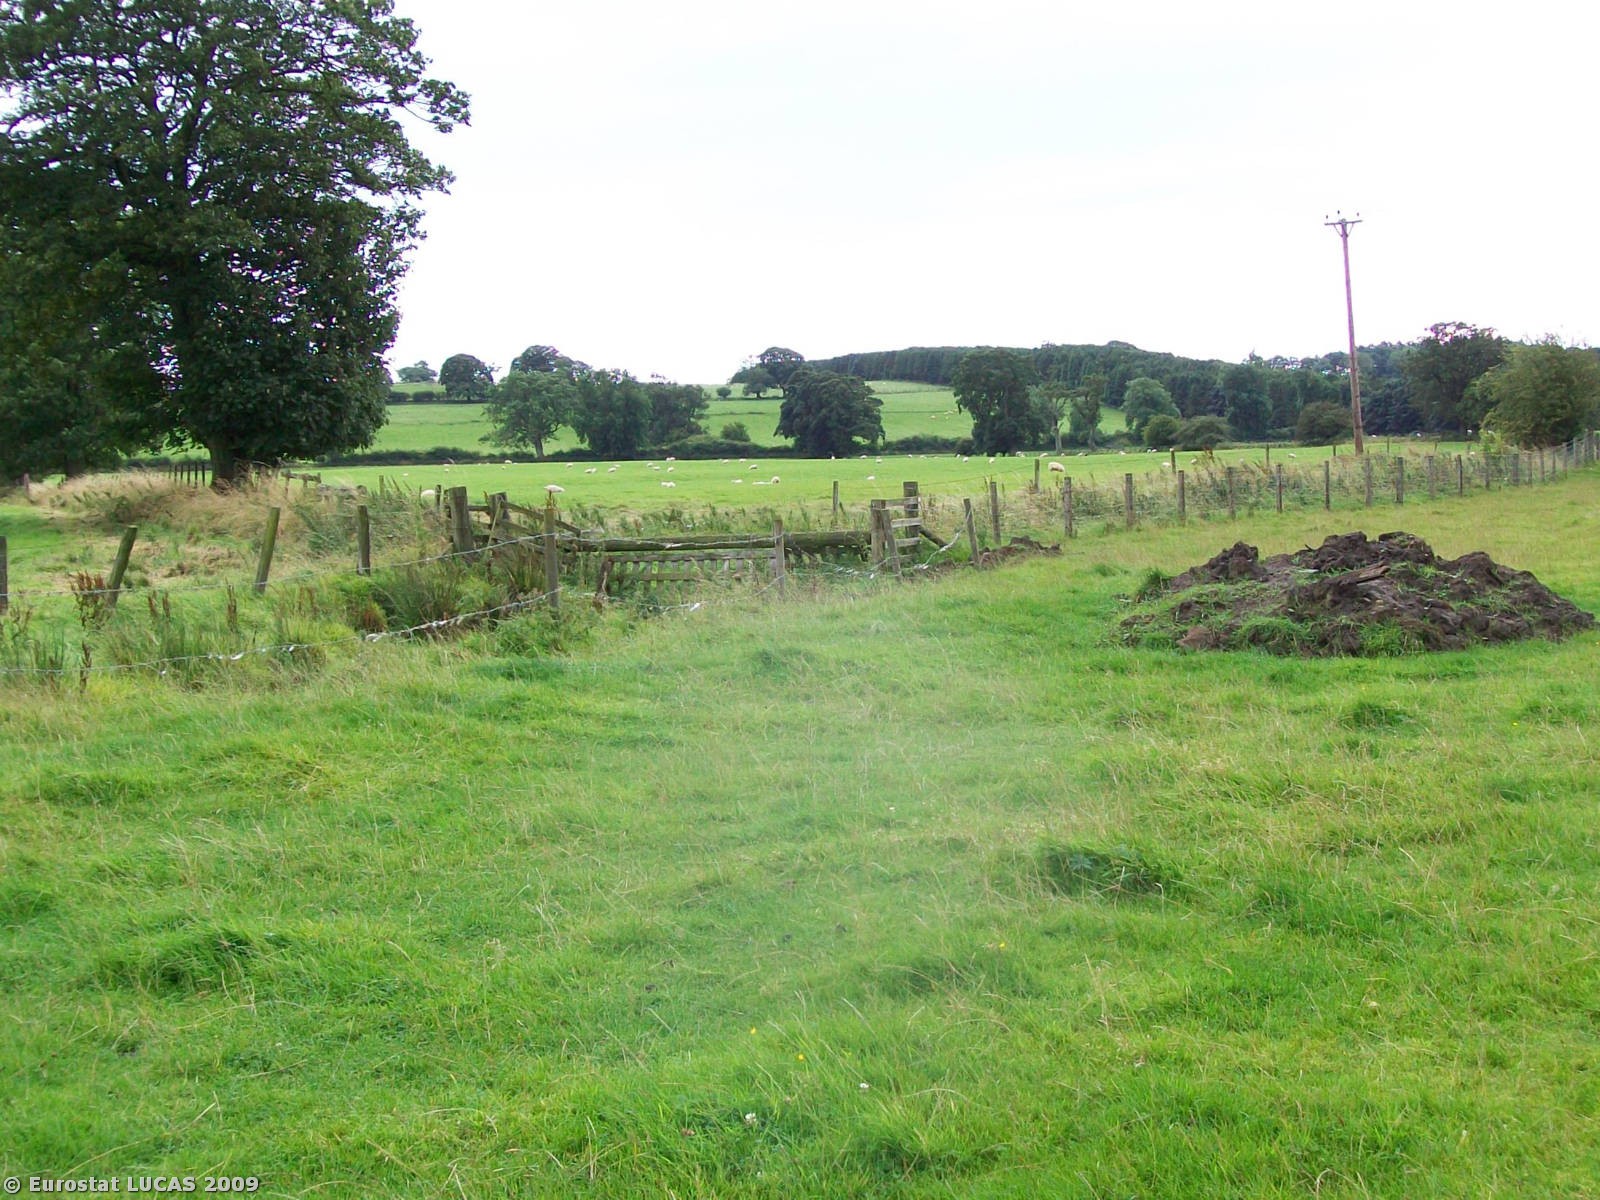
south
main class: Grassland
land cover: Grassland without tree/shrub cover
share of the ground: > 75 %
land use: Agriculture (excluding fallow land and kitchen gardens)
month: September
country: GB
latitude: 55.0228
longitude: -1.9891
